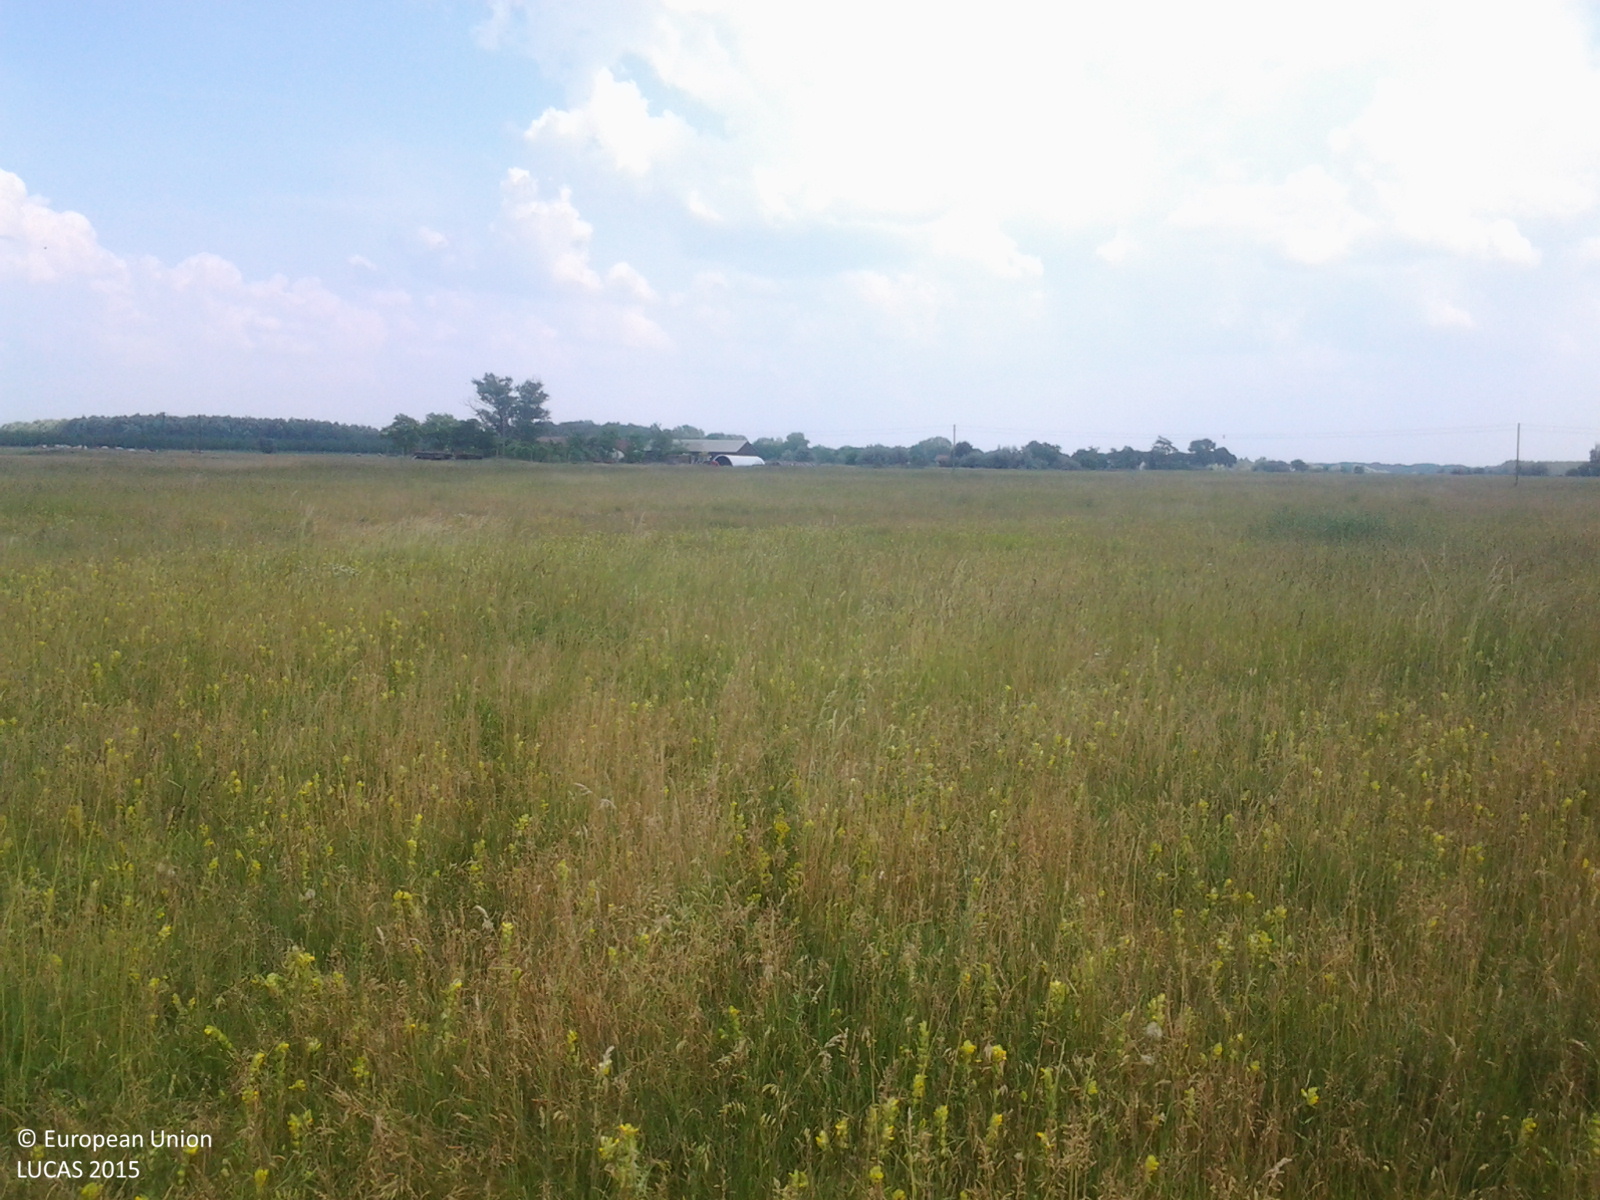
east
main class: Grassland
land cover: Grassland without tree/shrub cover
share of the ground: > 75 %
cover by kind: herbaceous plants 100 %
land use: Agriculture (excluding fallow land and kitchen gardens)
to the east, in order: Grassland without tree/shrub cover; Inland fresh running water; Grass margins; Tracks; Grassland without tree/shrub cover; Fences; Grassland without tree/shrub cover; Electric lines; Grassland without tree/shrub cover
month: June
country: HU
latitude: 46.9177
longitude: 19.7779
